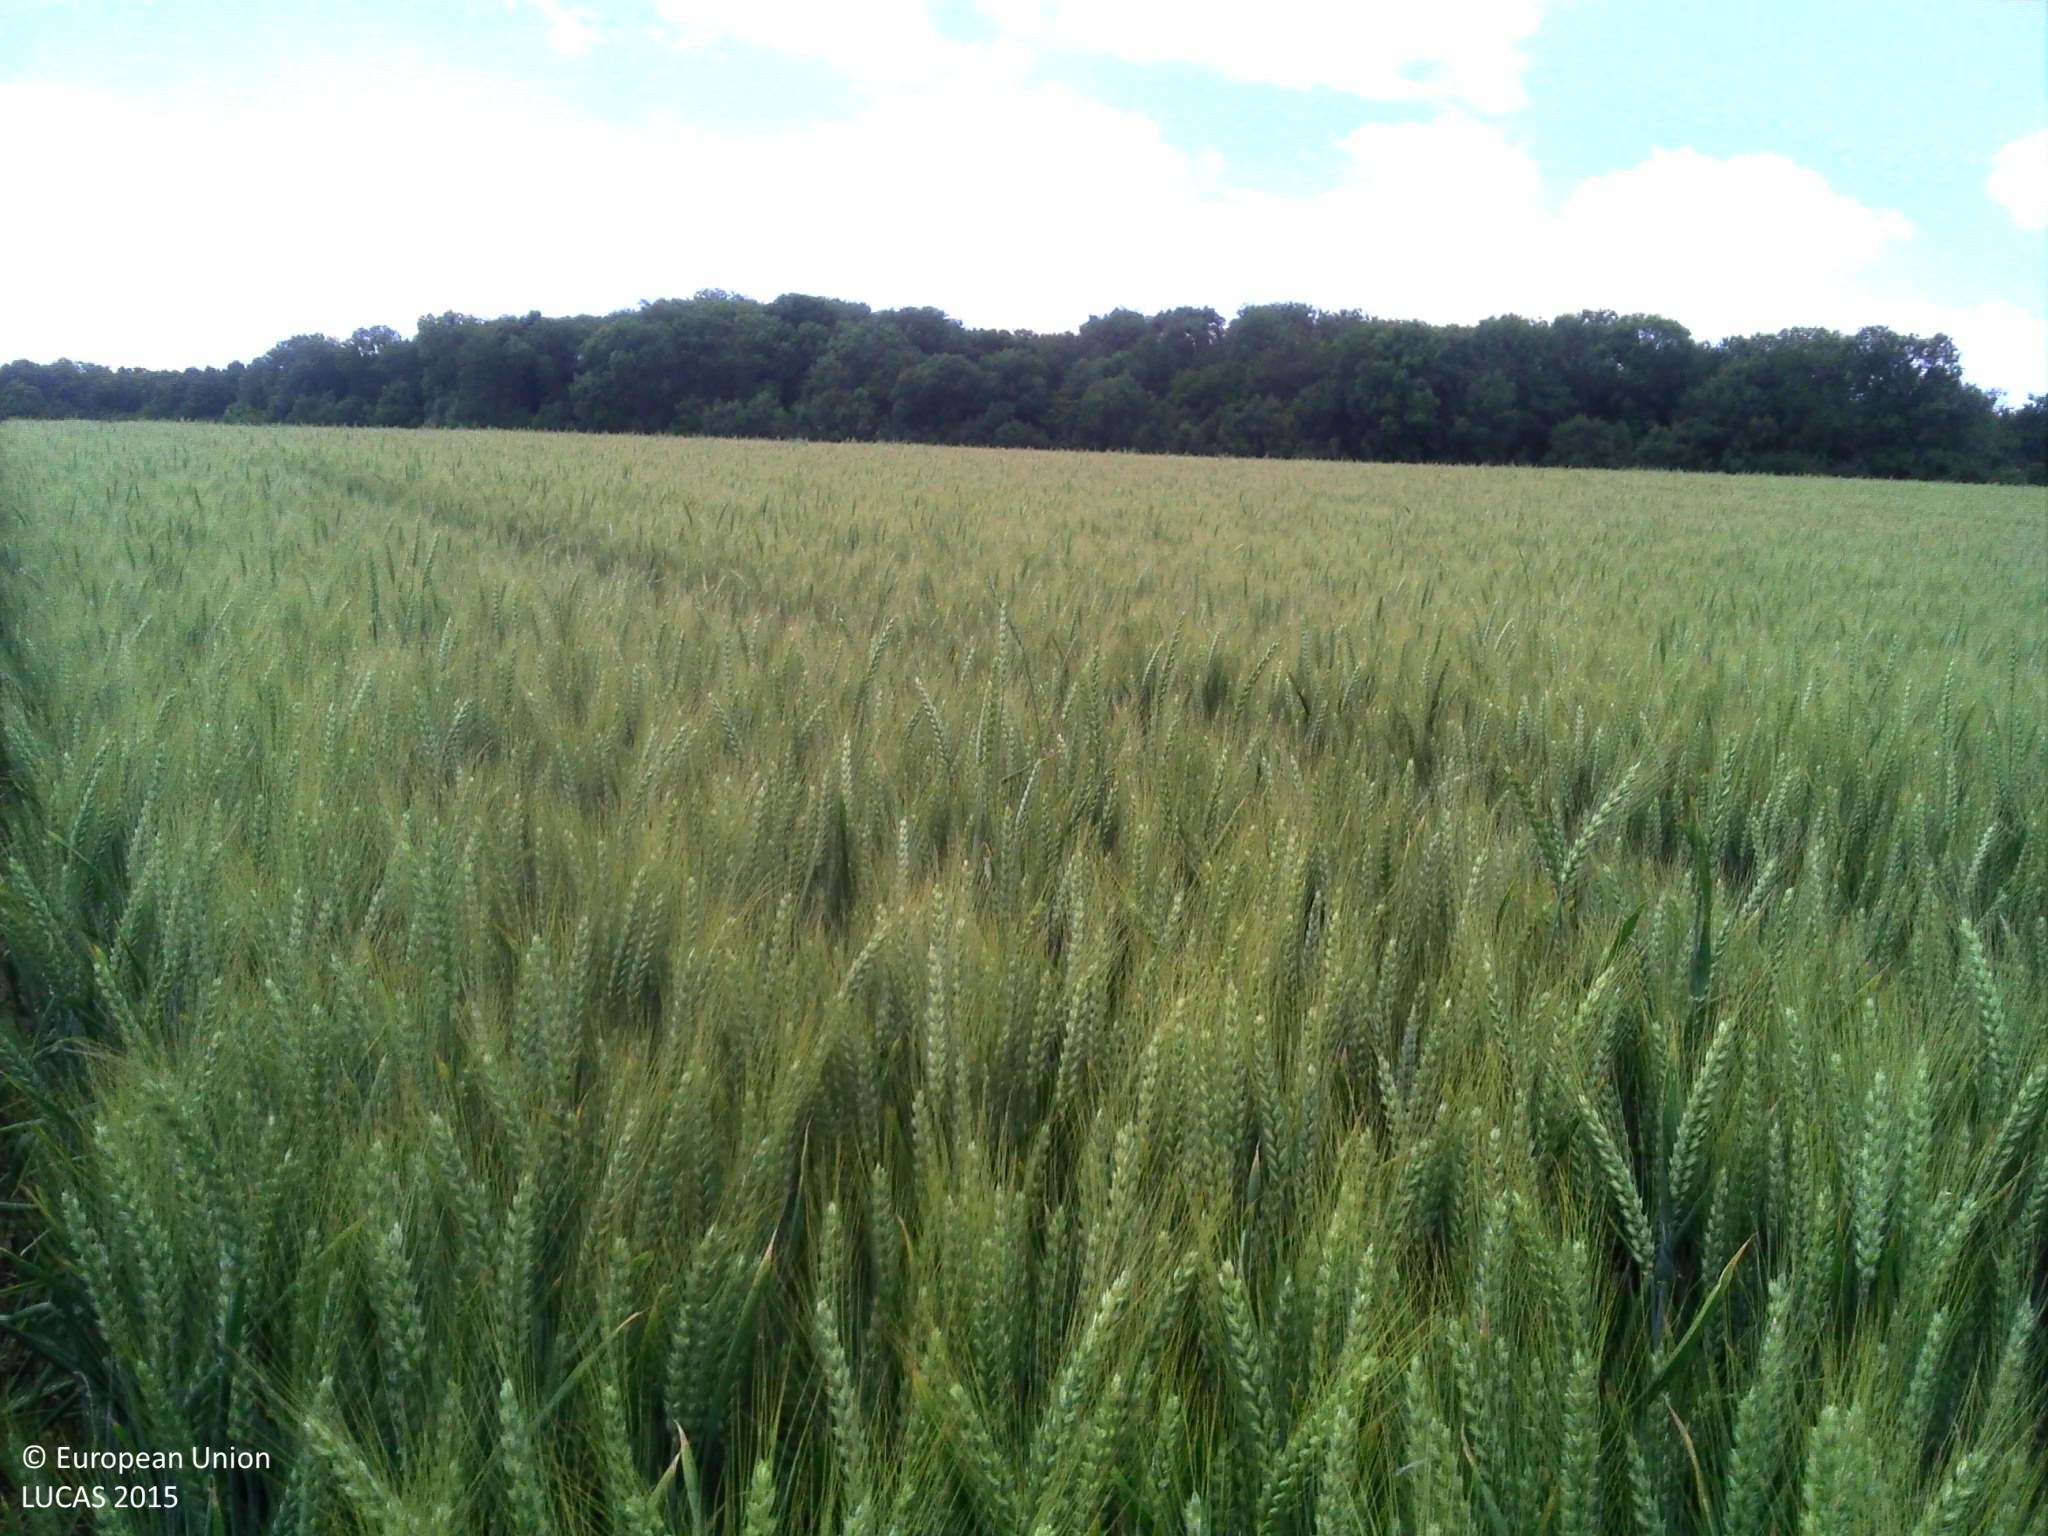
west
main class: Cropland
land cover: Durum wheat
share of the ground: > 75 %
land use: Agriculture (excluding fallow land and kitchen gardens)
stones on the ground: < 10 %
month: June
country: FR
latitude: 49.6675
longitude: 2.5199
